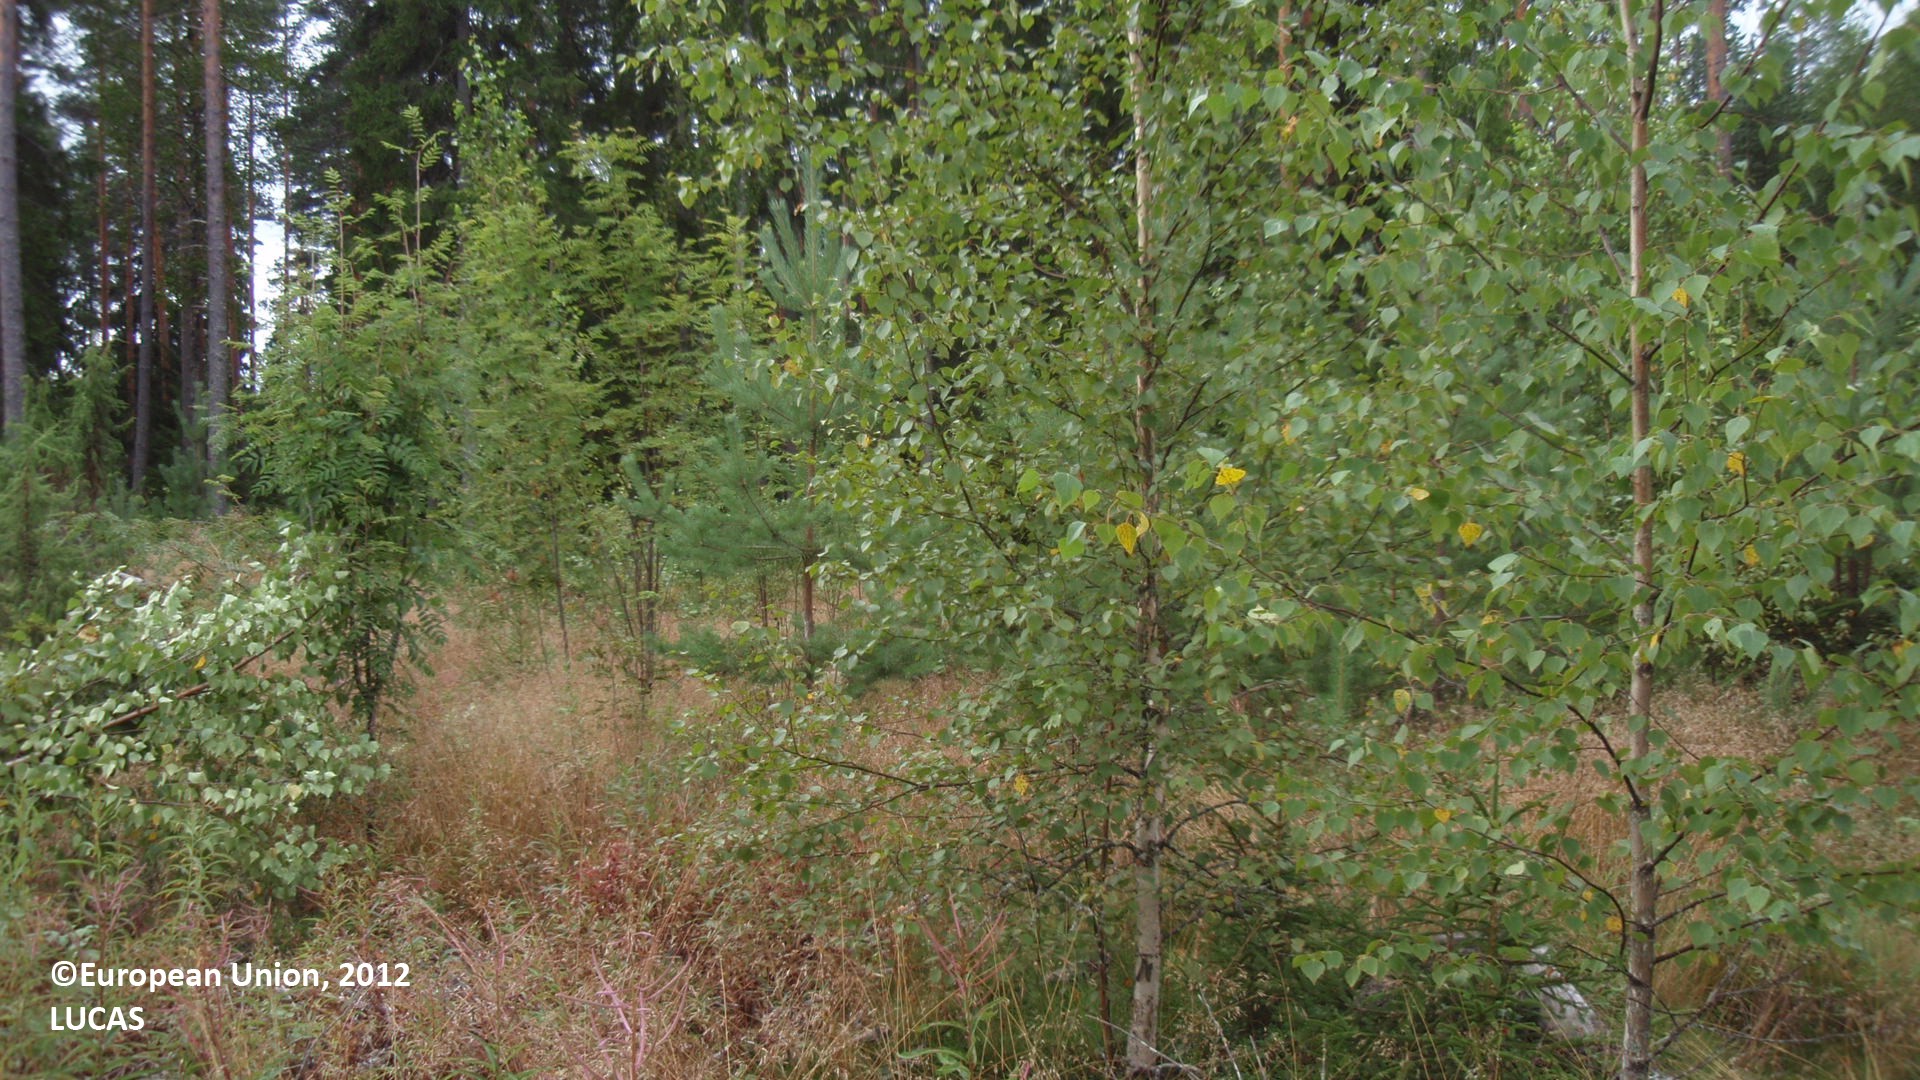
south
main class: Grassland
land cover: Grassland with sparse tree/shrub cover
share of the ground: 25 - 50 %
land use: Forestry
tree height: < 5 m
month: August
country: FI
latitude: 61.0853
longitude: 27.4025
